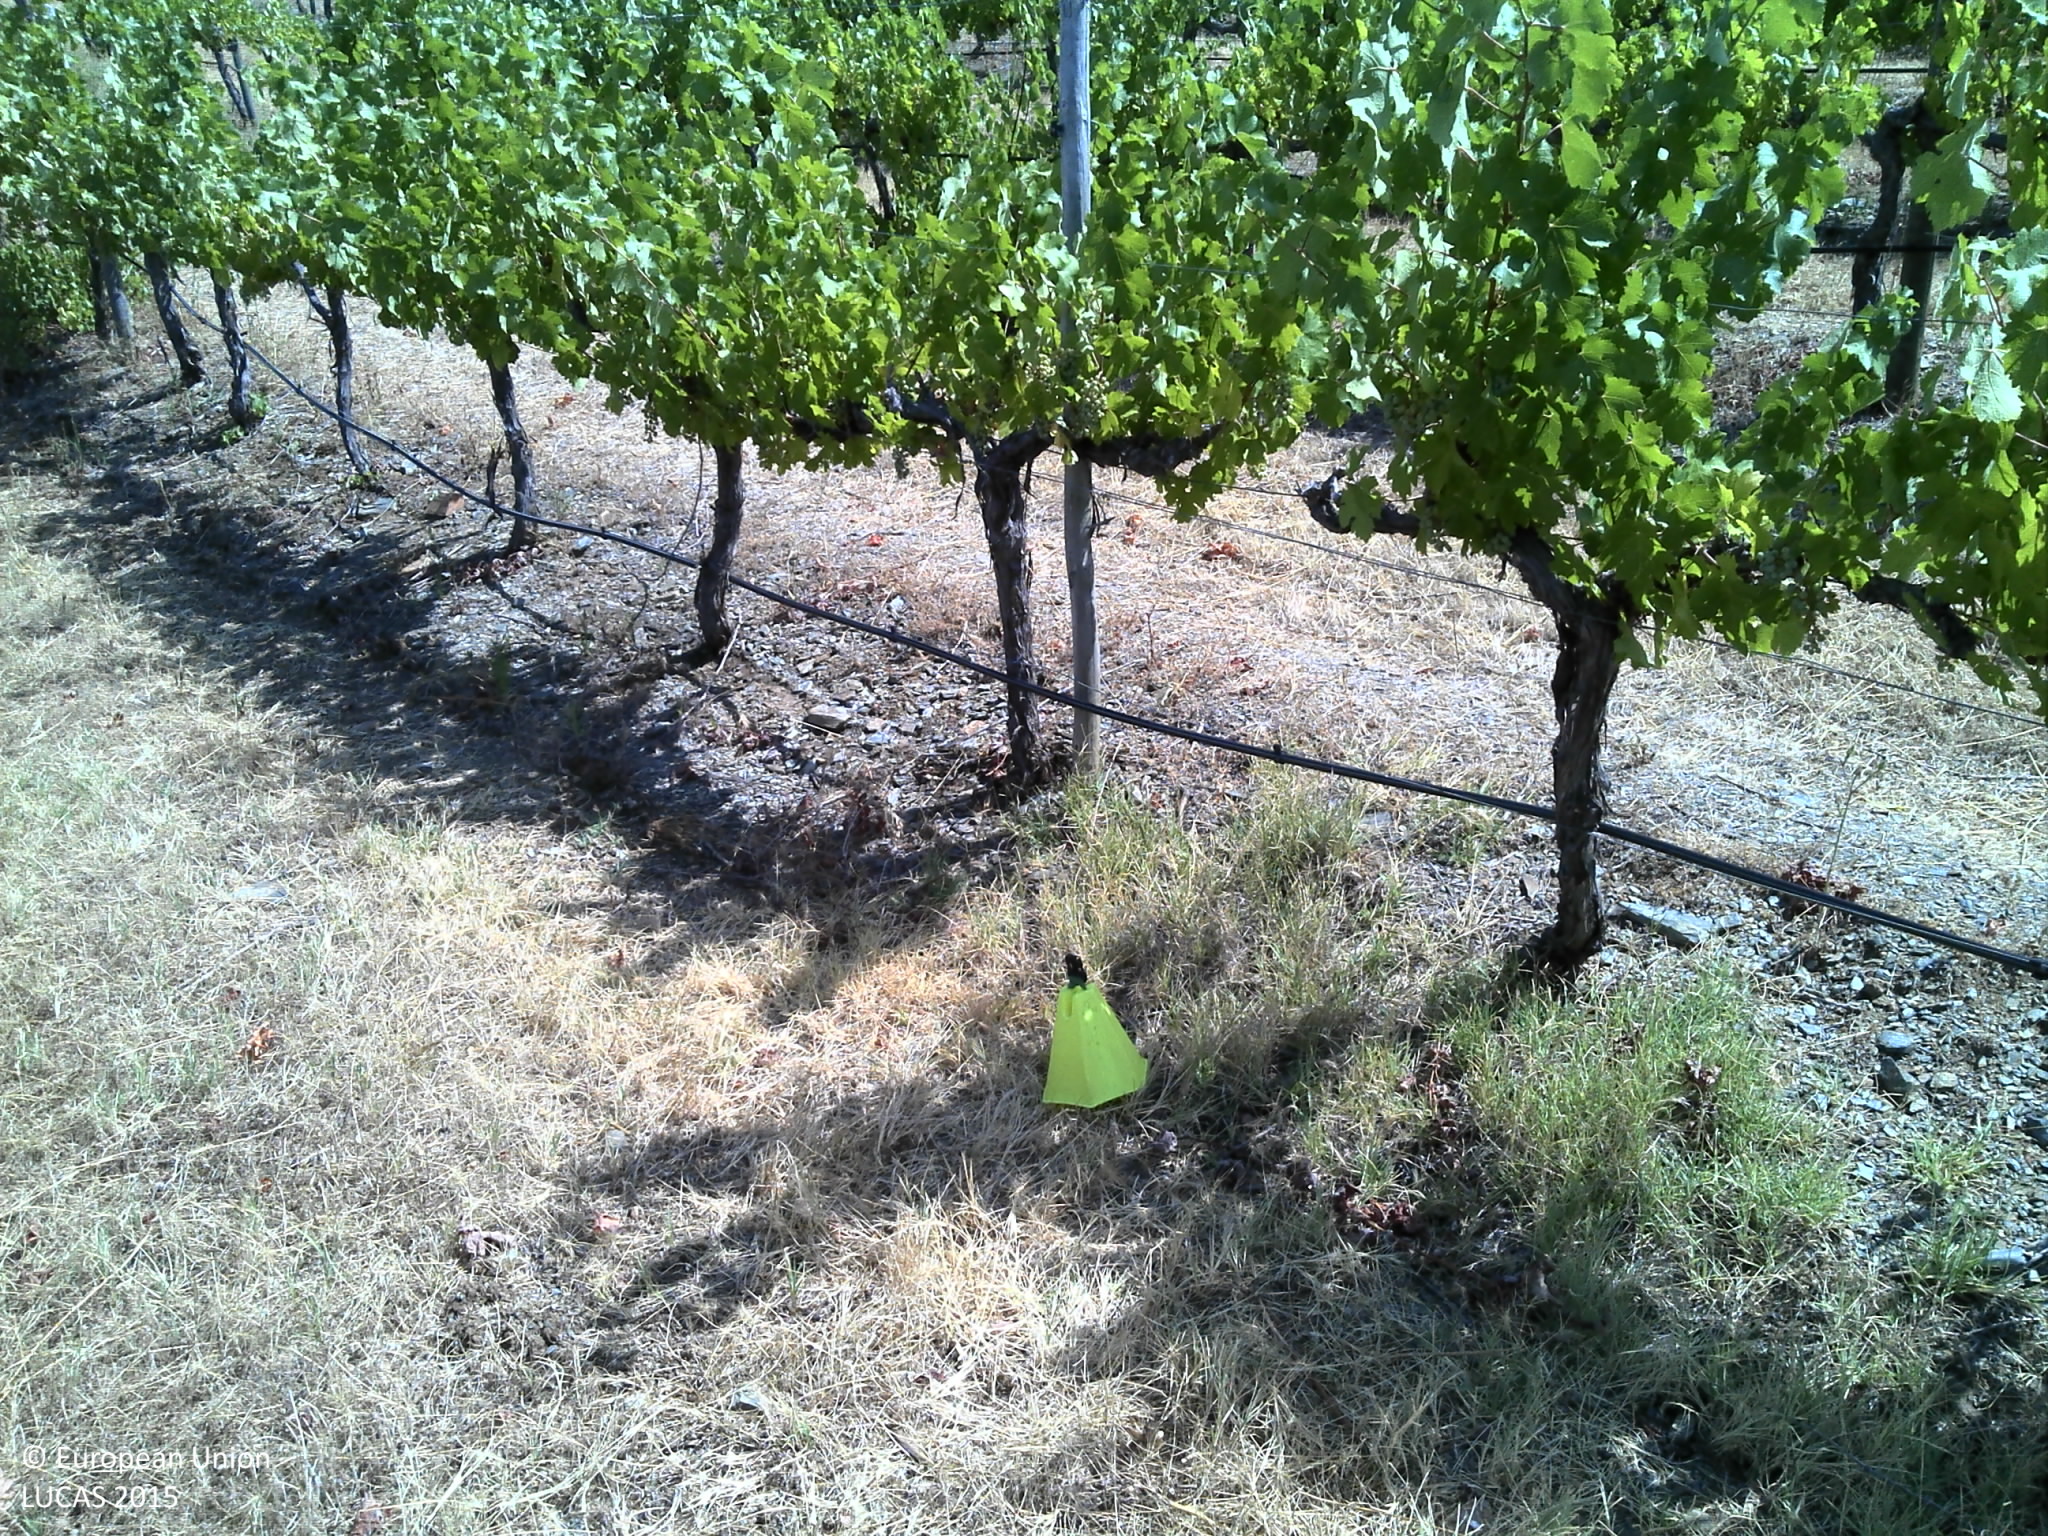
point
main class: Cropland
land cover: Vineyards
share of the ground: 25 - 50 %
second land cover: Grassland without tree/shrub cover
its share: 25 - 50 %
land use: Agriculture (excluding fallow land and kitchen gardens)
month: July
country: PT
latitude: 38.5037
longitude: -7.6570
